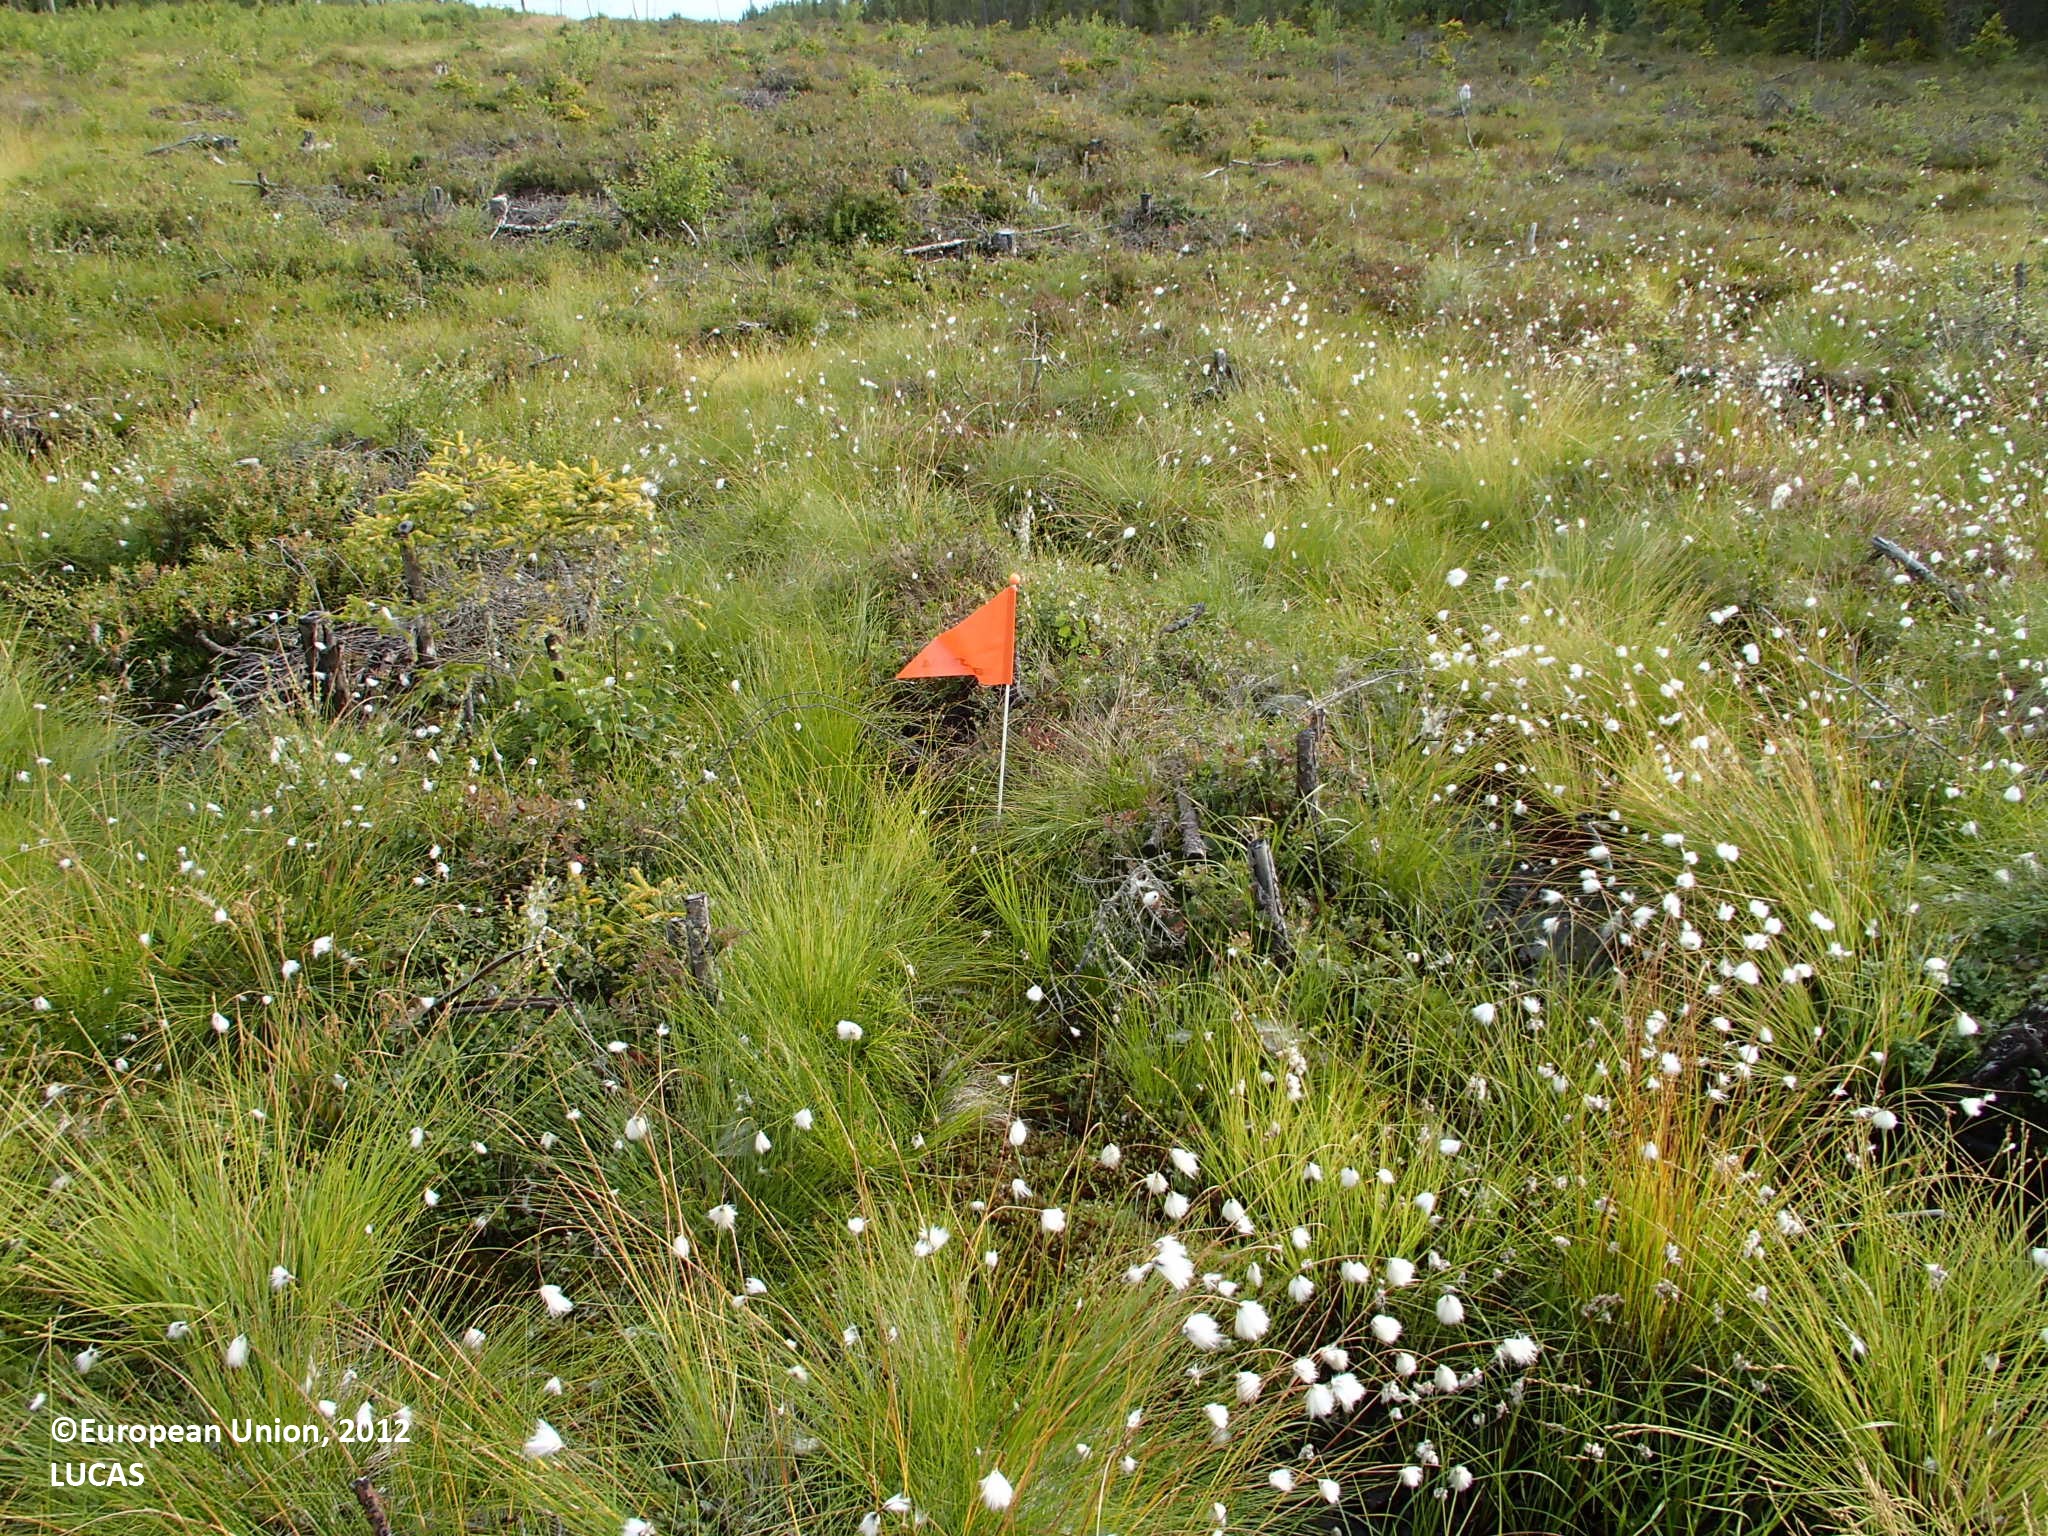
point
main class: Grassland
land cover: Grassland with sparse tree/shrub cover
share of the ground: > 75 %
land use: Energy production
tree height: < 5 m
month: July
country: FI
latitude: 66.4382
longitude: 25.5571
